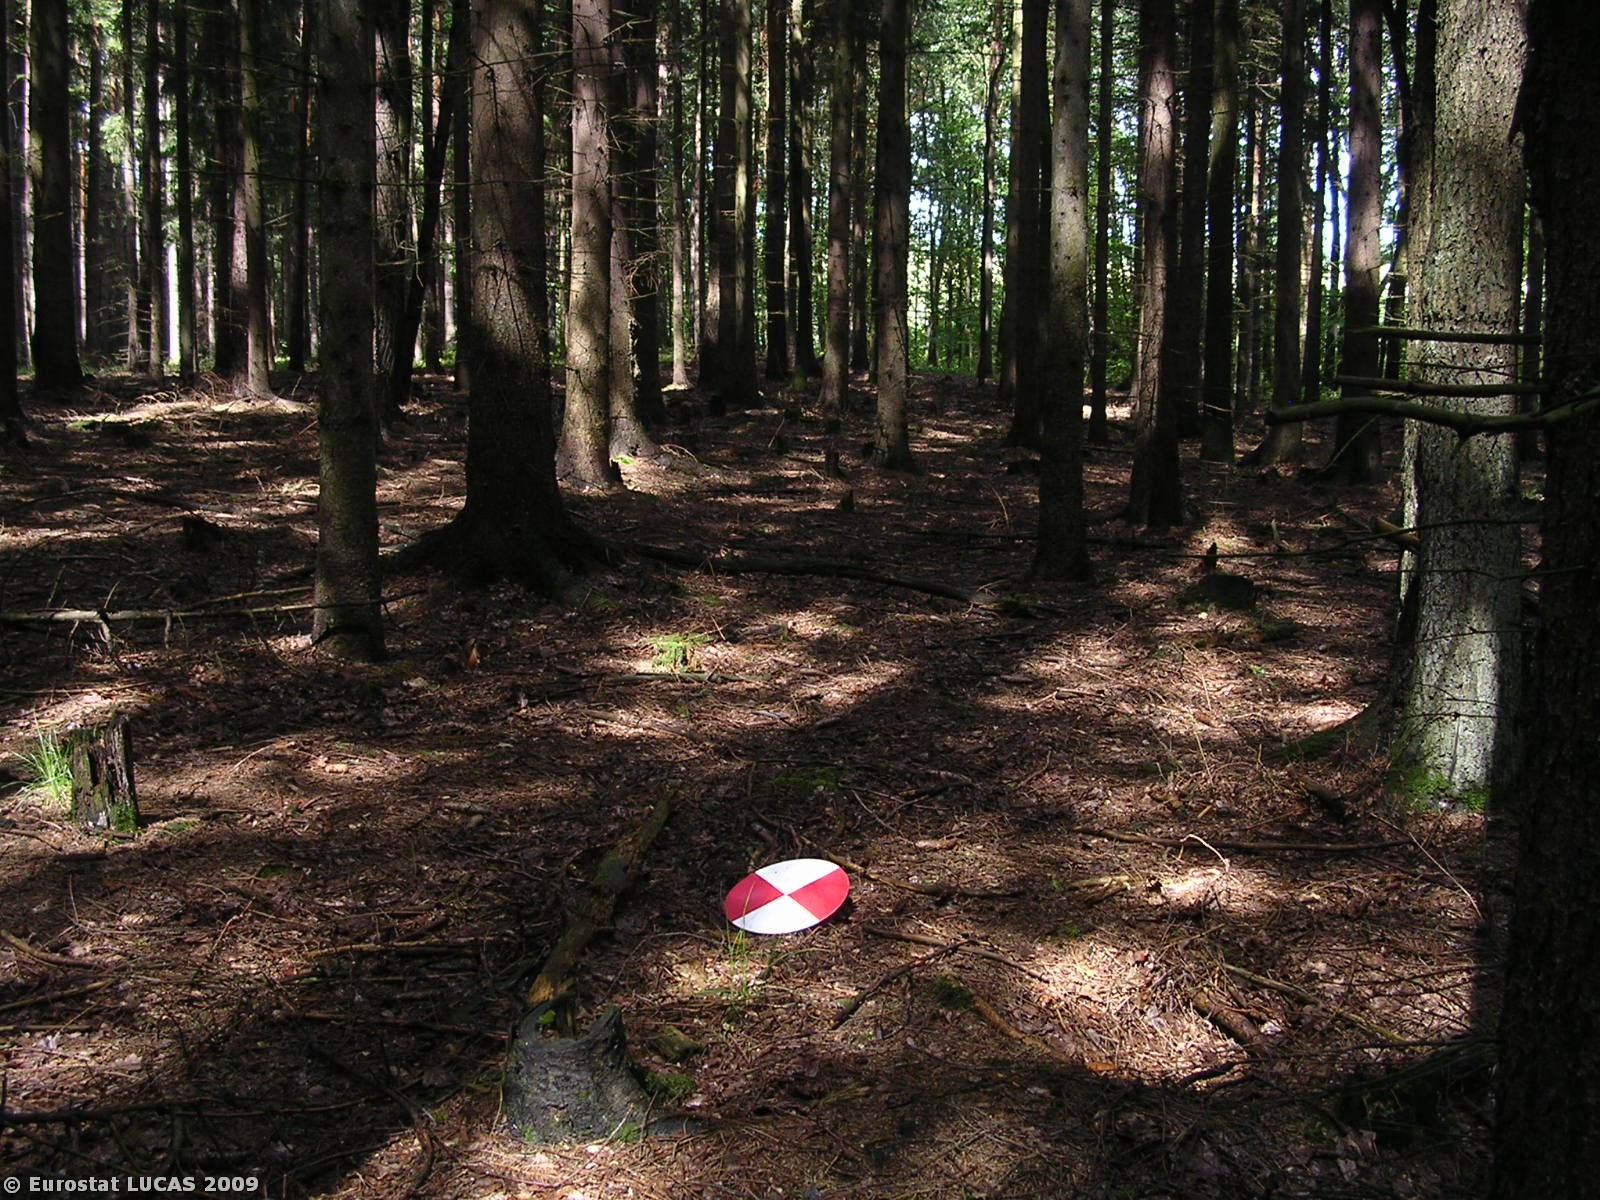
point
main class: Woodland
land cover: Coniferous woodland
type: hemiboreal forest and nemoral coniferous forest and mixed broadleaved-coniferous forest
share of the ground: > 75 %
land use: Forestry
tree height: > 5 m
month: July
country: CZ
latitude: 50.9716
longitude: 15.0872
